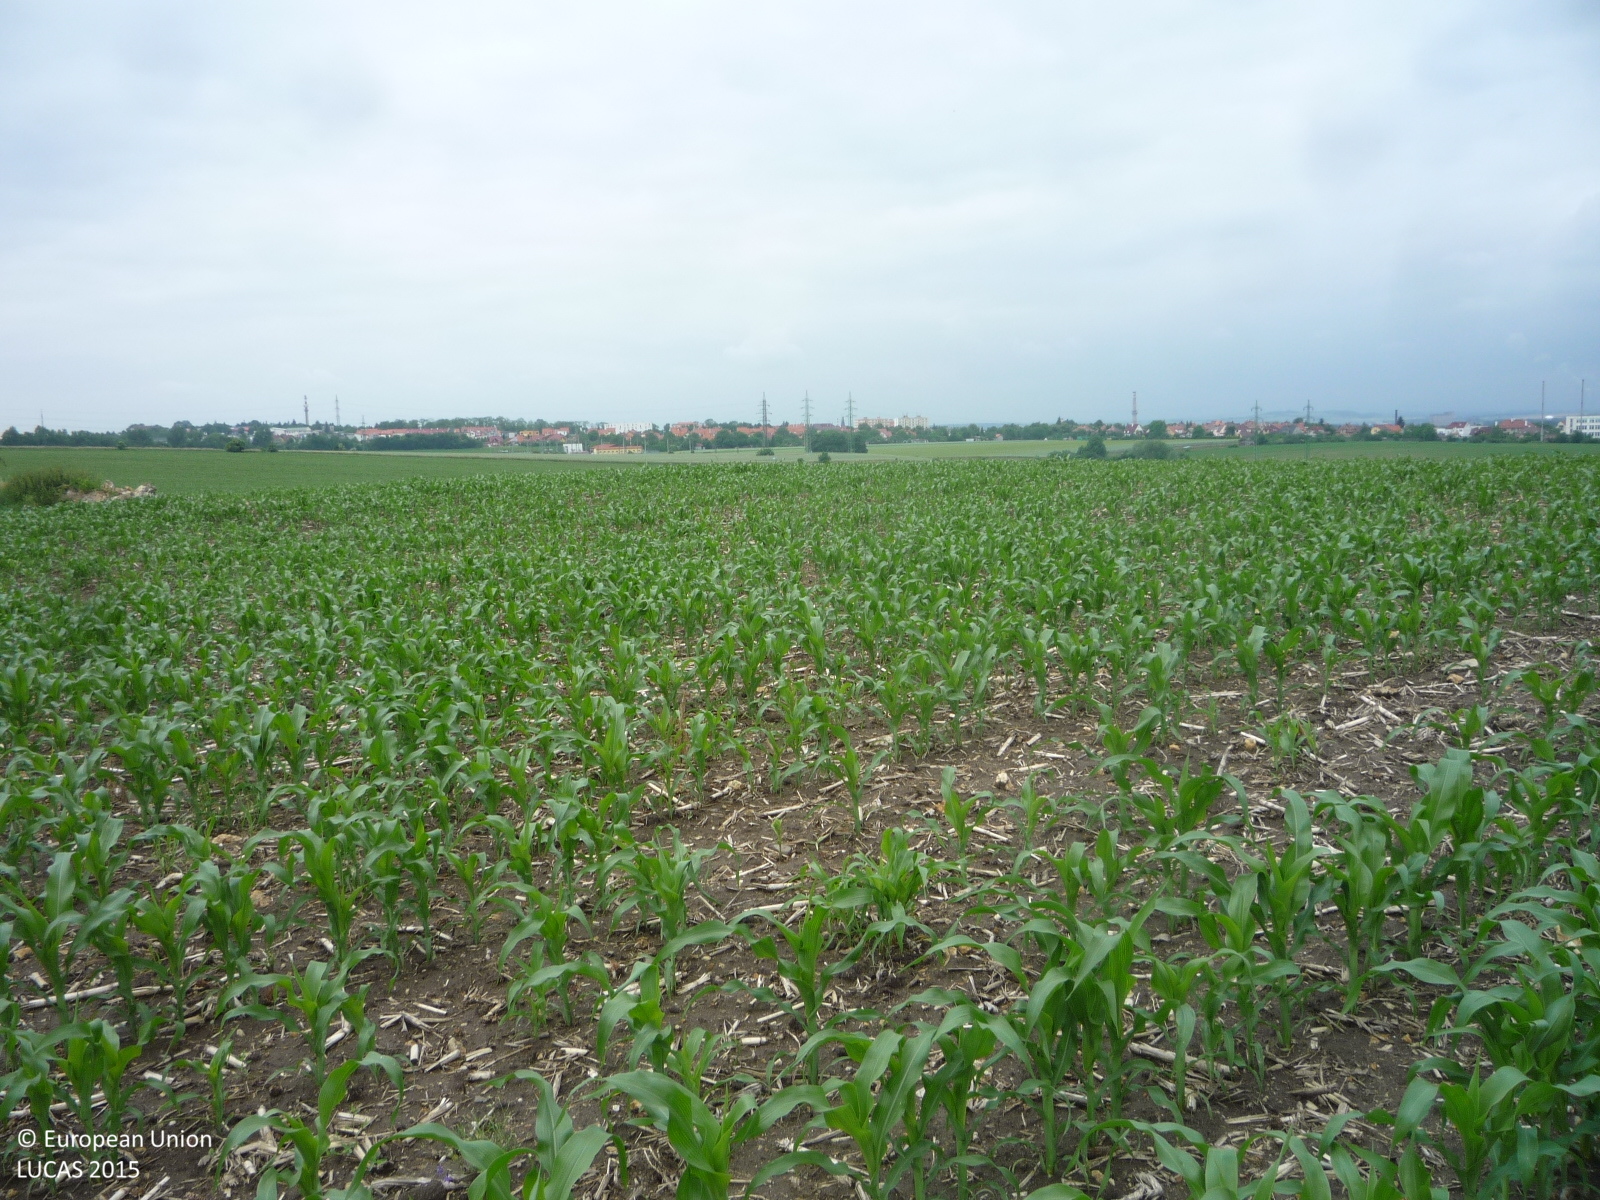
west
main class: Cropland
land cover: Maize
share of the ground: 25 - 50 %
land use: Agriculture (excluding fallow land and kitchen gardens)
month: June
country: CZ
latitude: 50.3537
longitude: 13.8377
